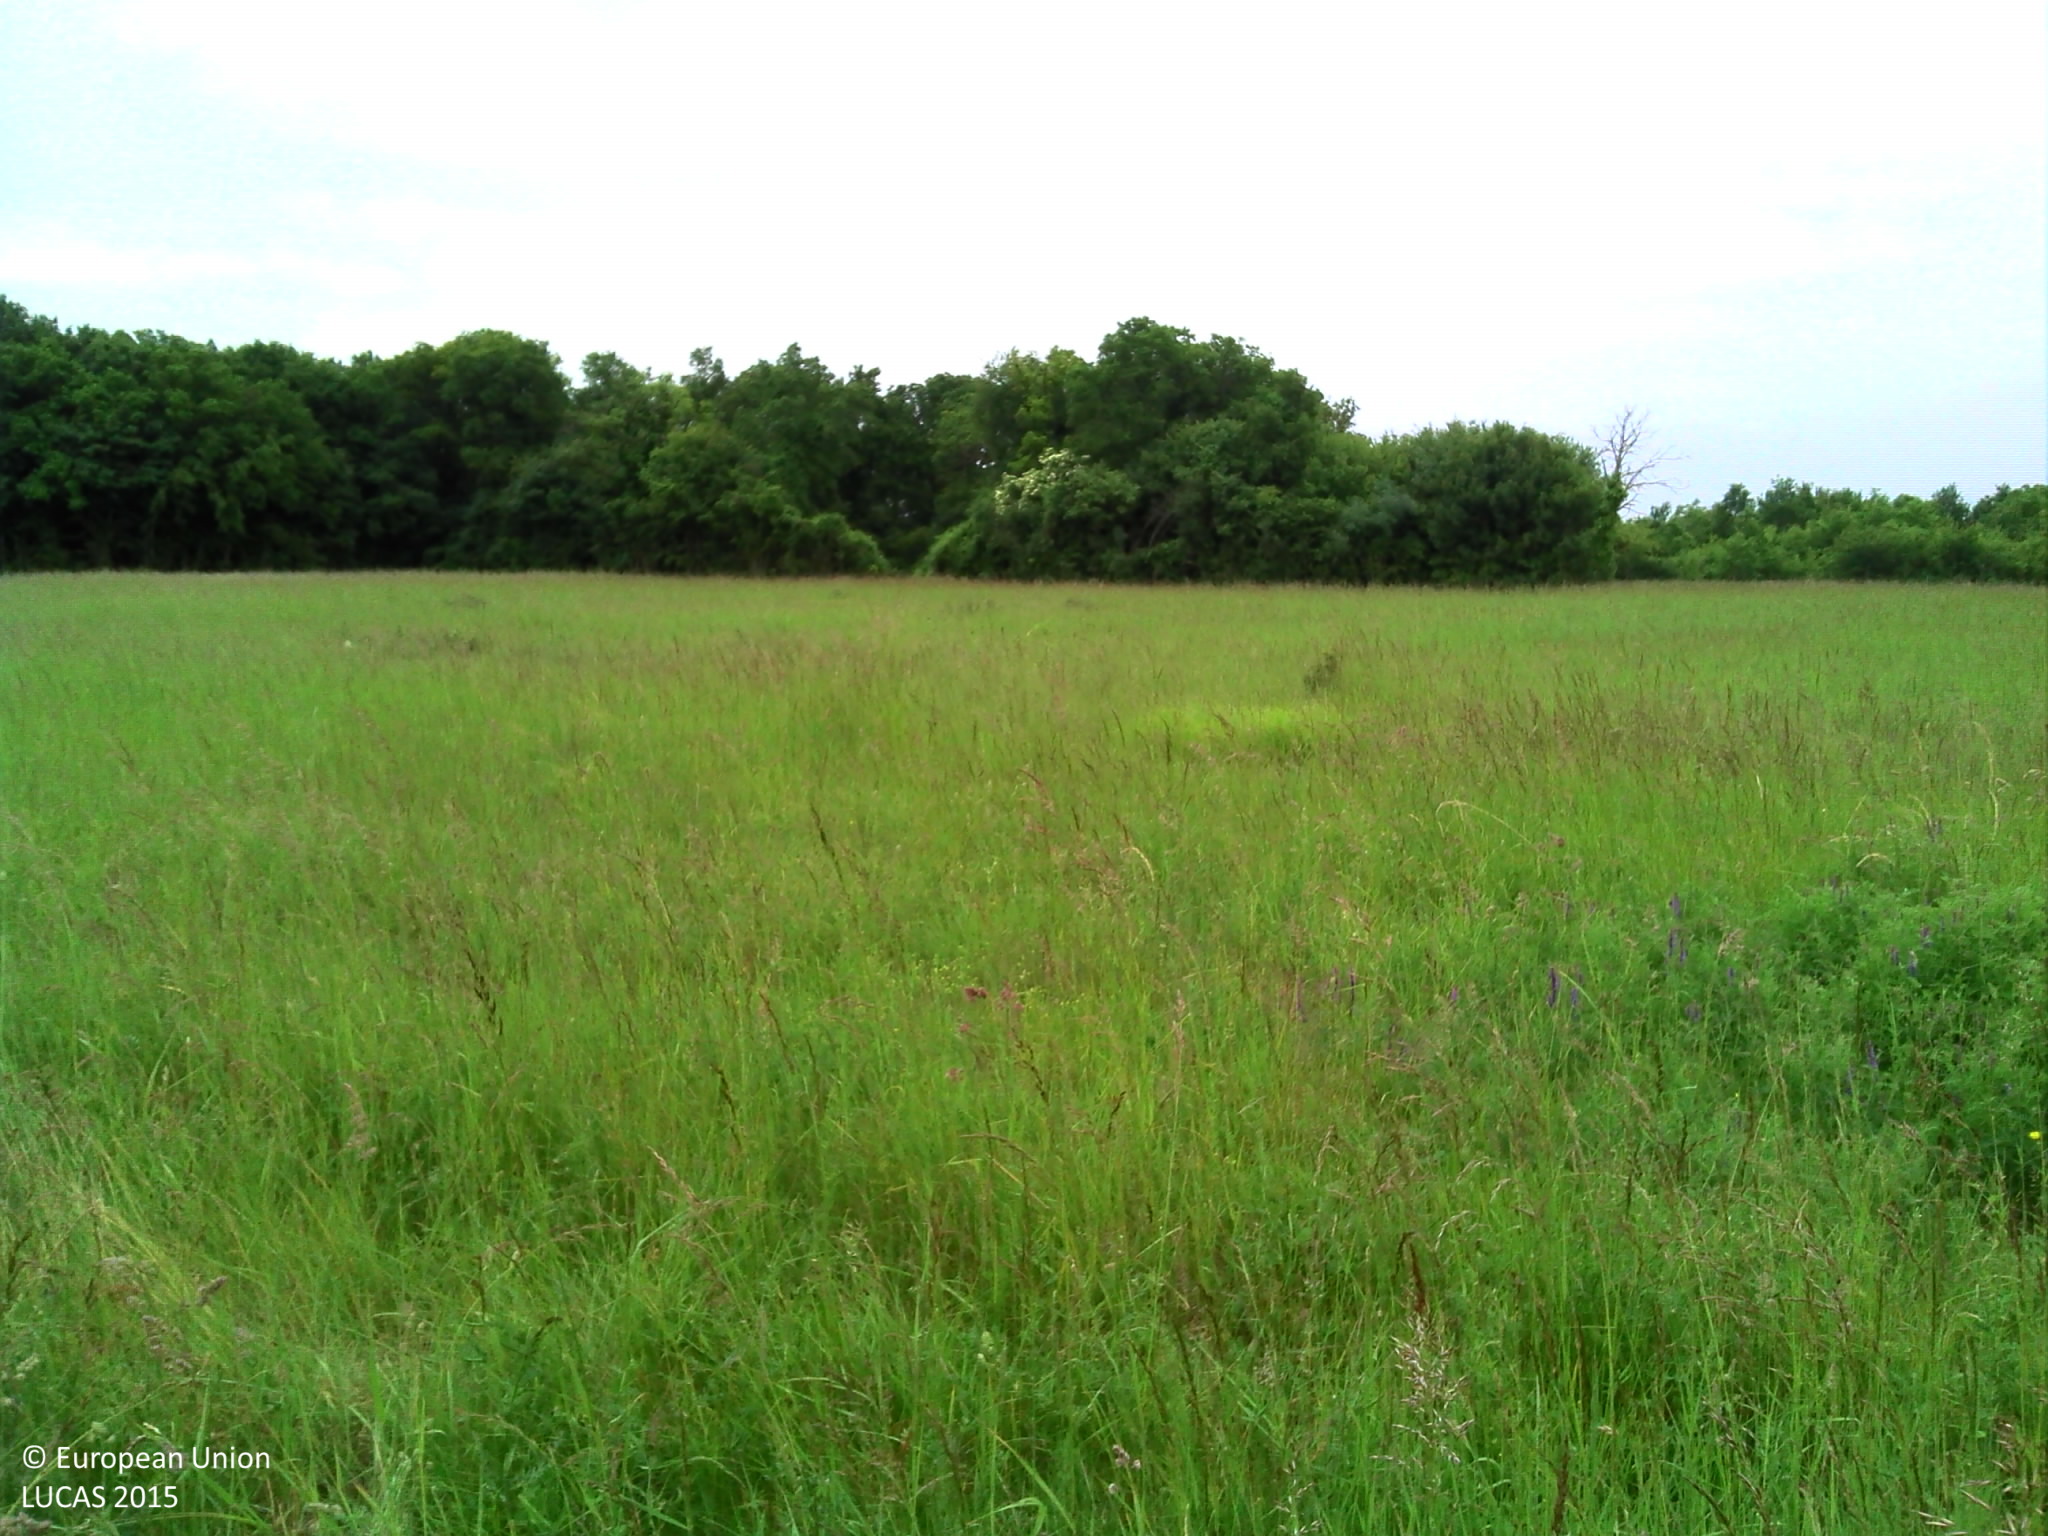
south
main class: Cropland
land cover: Rape and turnip rape
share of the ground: > 75 %
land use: Agriculture (excluding fallow land and kitchen gardens)
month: May
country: FR
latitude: 47.1266
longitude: 2.8896
